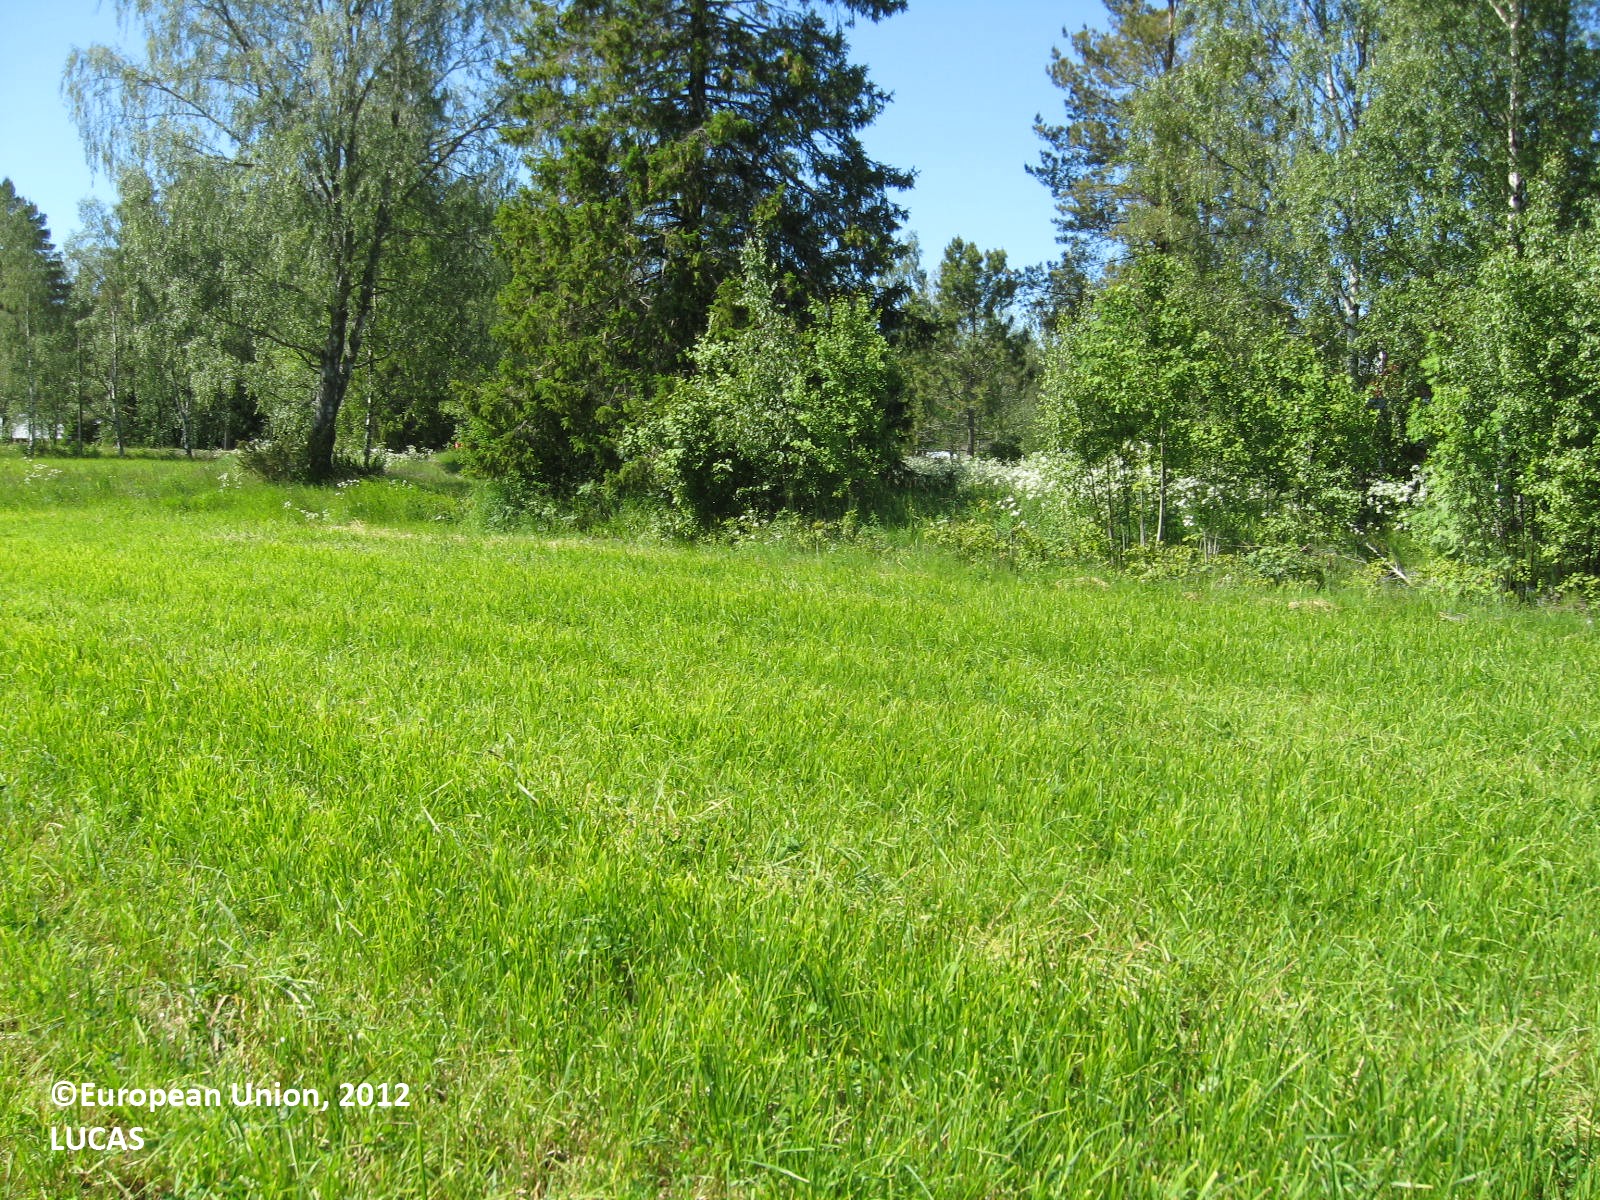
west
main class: Cropland
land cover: Other leguminous and mixtures for fodder
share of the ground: > 75 %
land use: Agriculture (excluding fallow land and kitchen gardens)
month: June
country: FI
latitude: 62.7901
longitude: 21.2713
